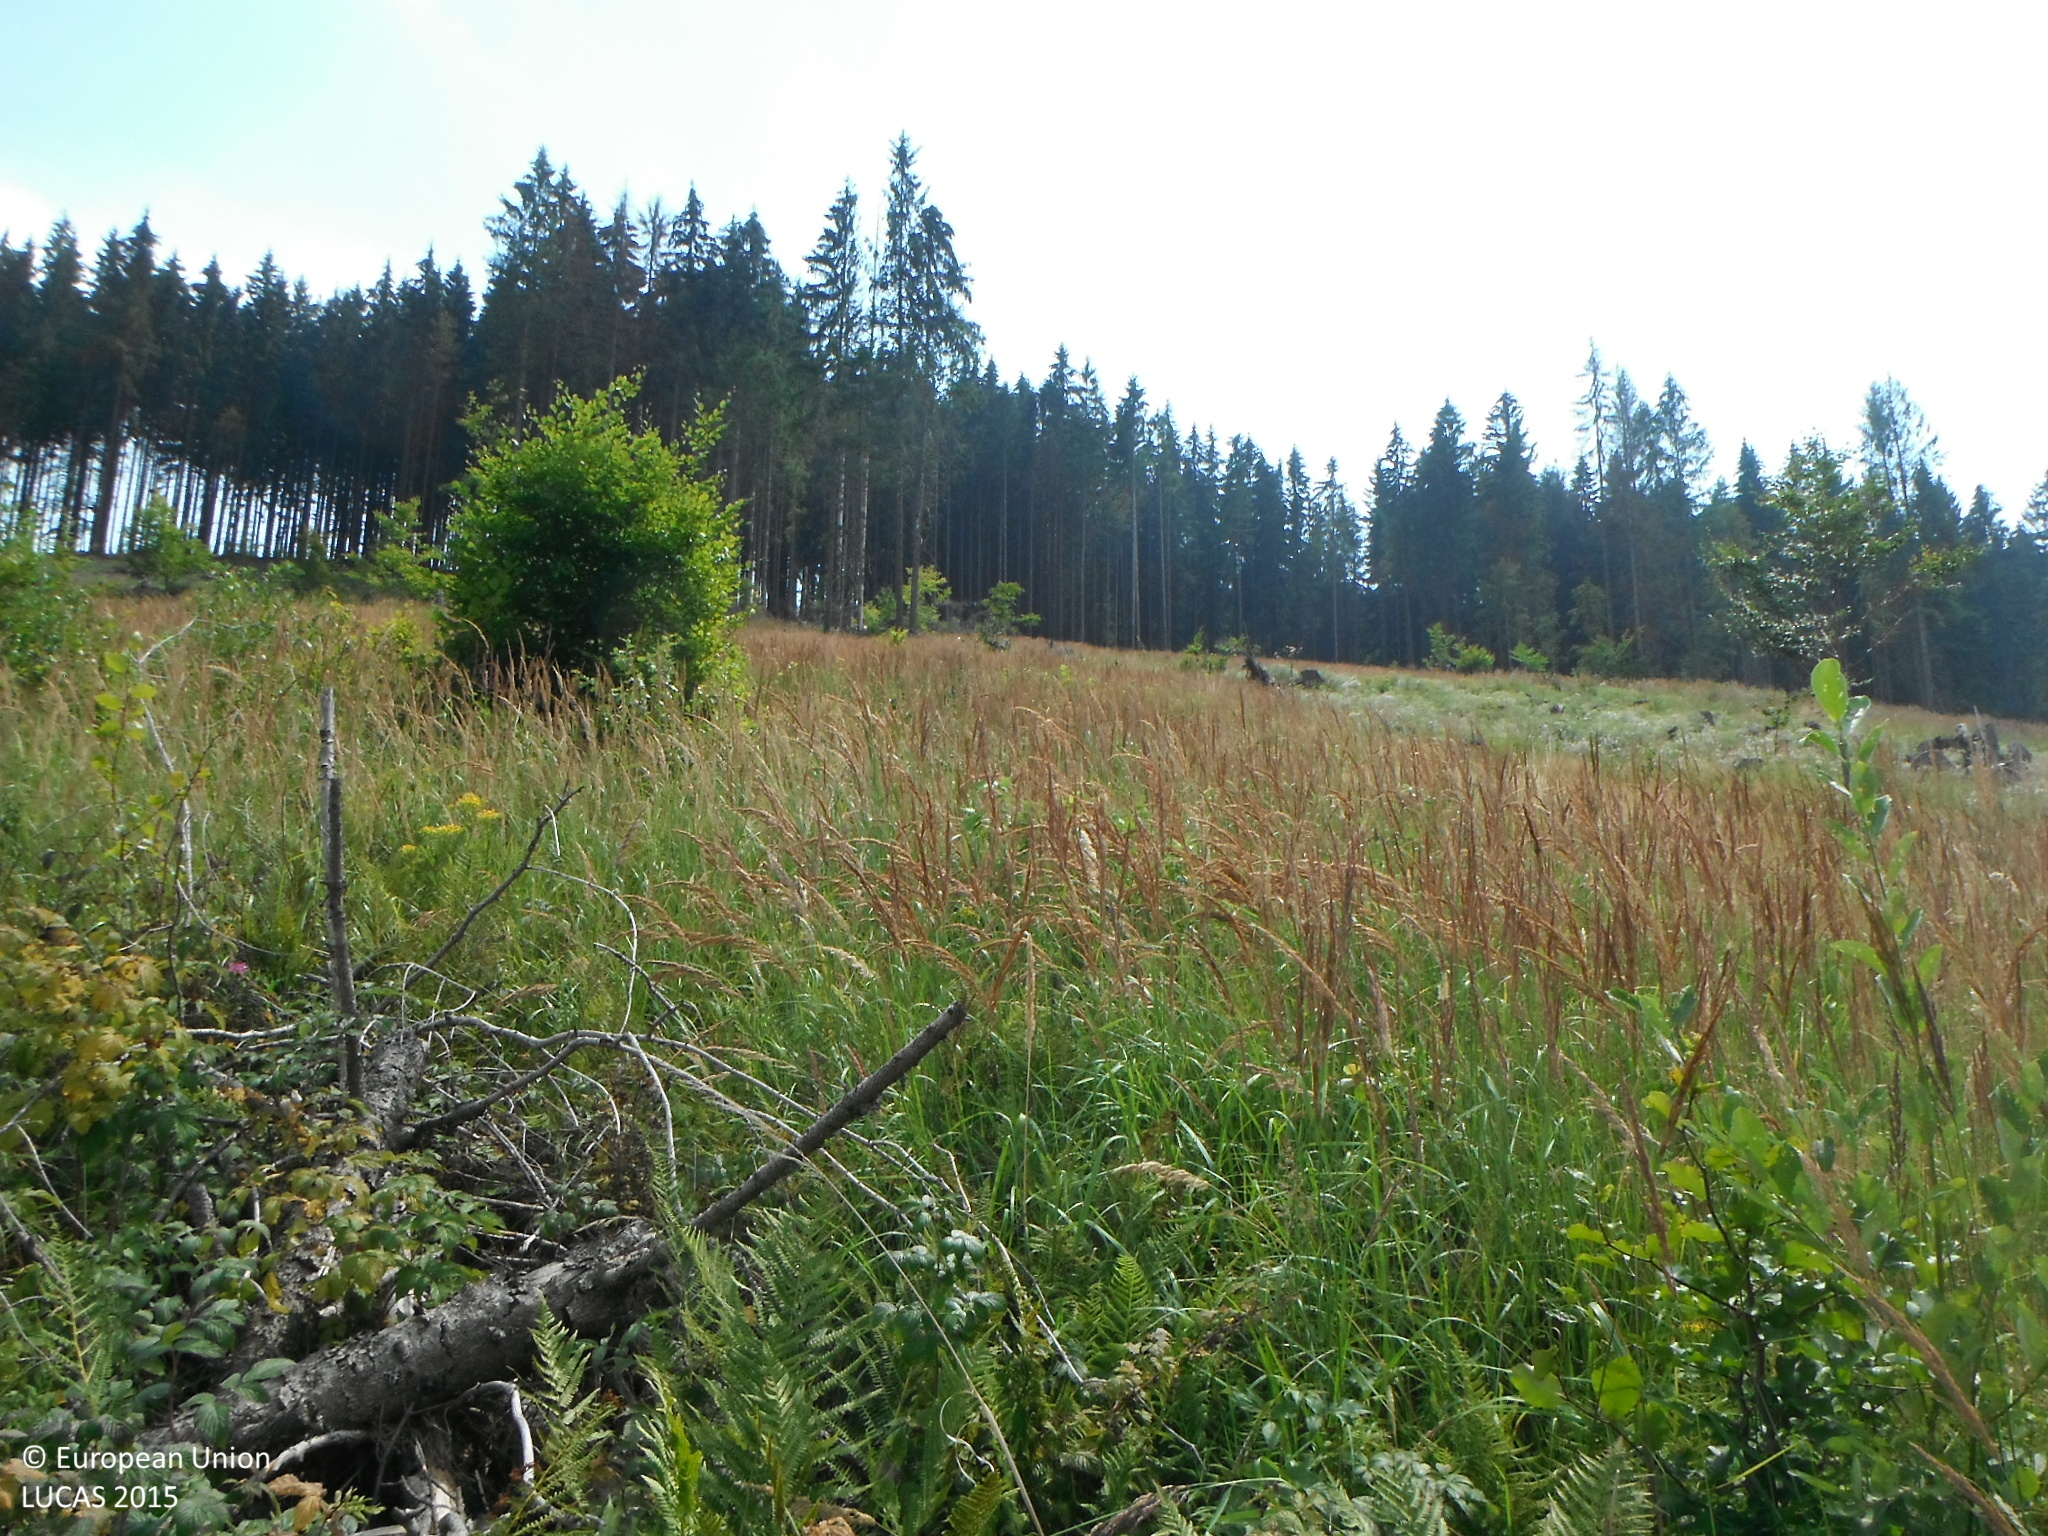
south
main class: Shrubland
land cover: Shrubland without tree cover
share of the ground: > 75 %
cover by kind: shrubs 80 %, herbaceous plants 20 %
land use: Forestry
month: August
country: SK
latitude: 49.2623
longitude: 18.8288
